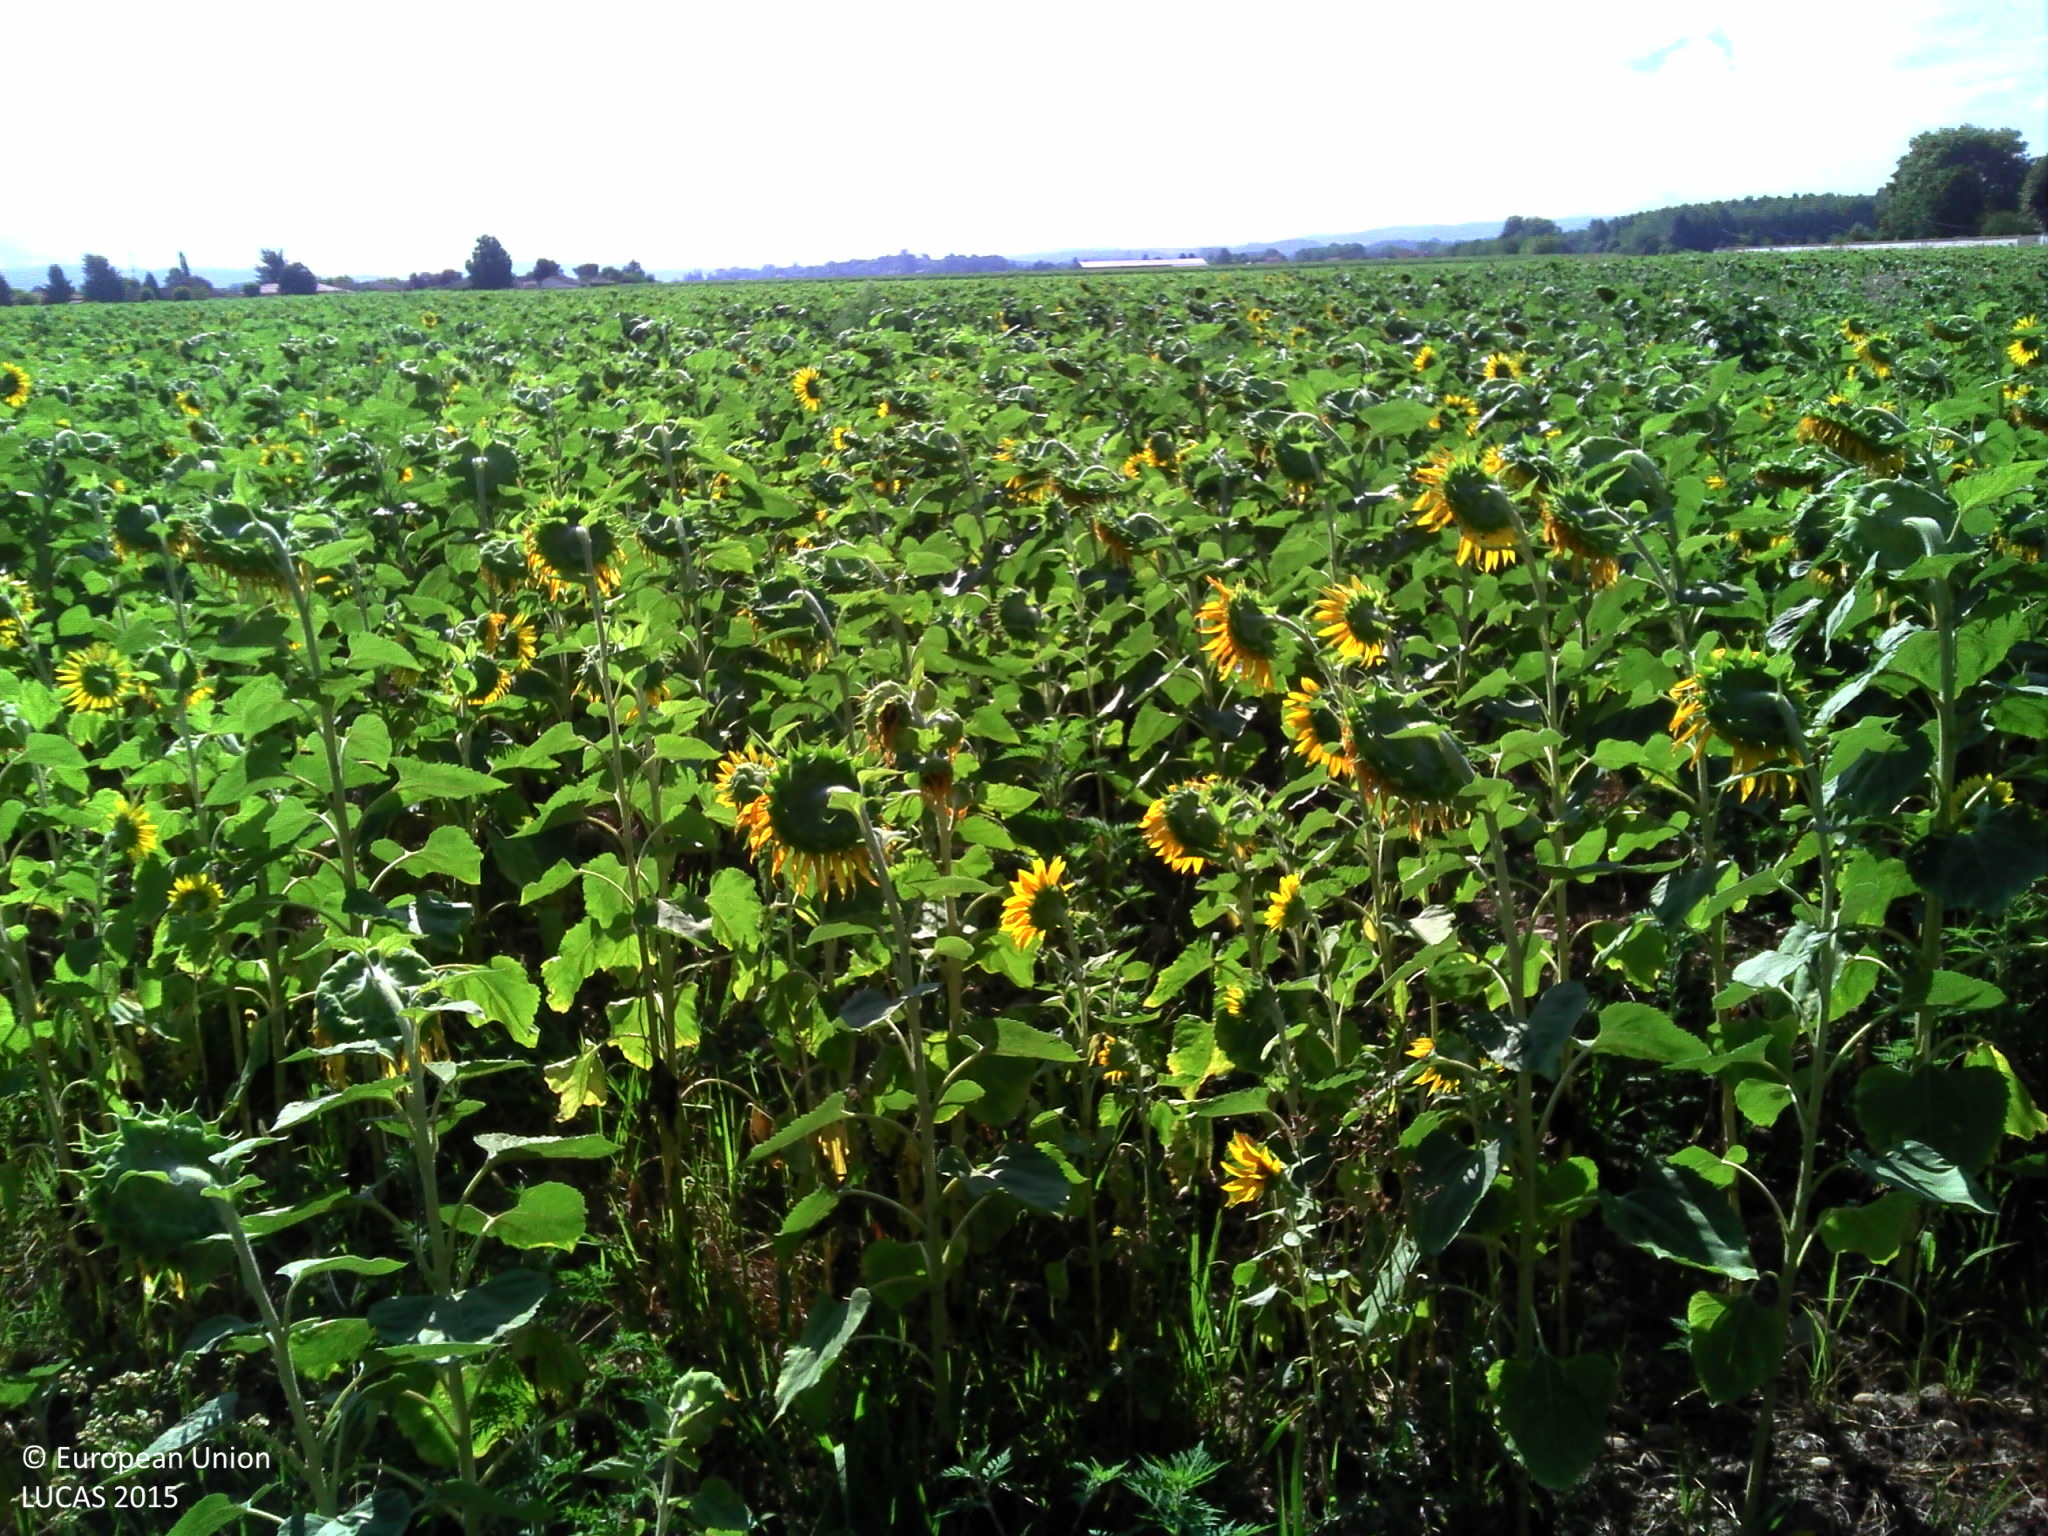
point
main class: Cropland
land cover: Sunflower
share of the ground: > 75 %
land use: Agriculture (excluding fallow land and kitchen gardens)
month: July
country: FR
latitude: 45.5099
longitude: 4.9483
